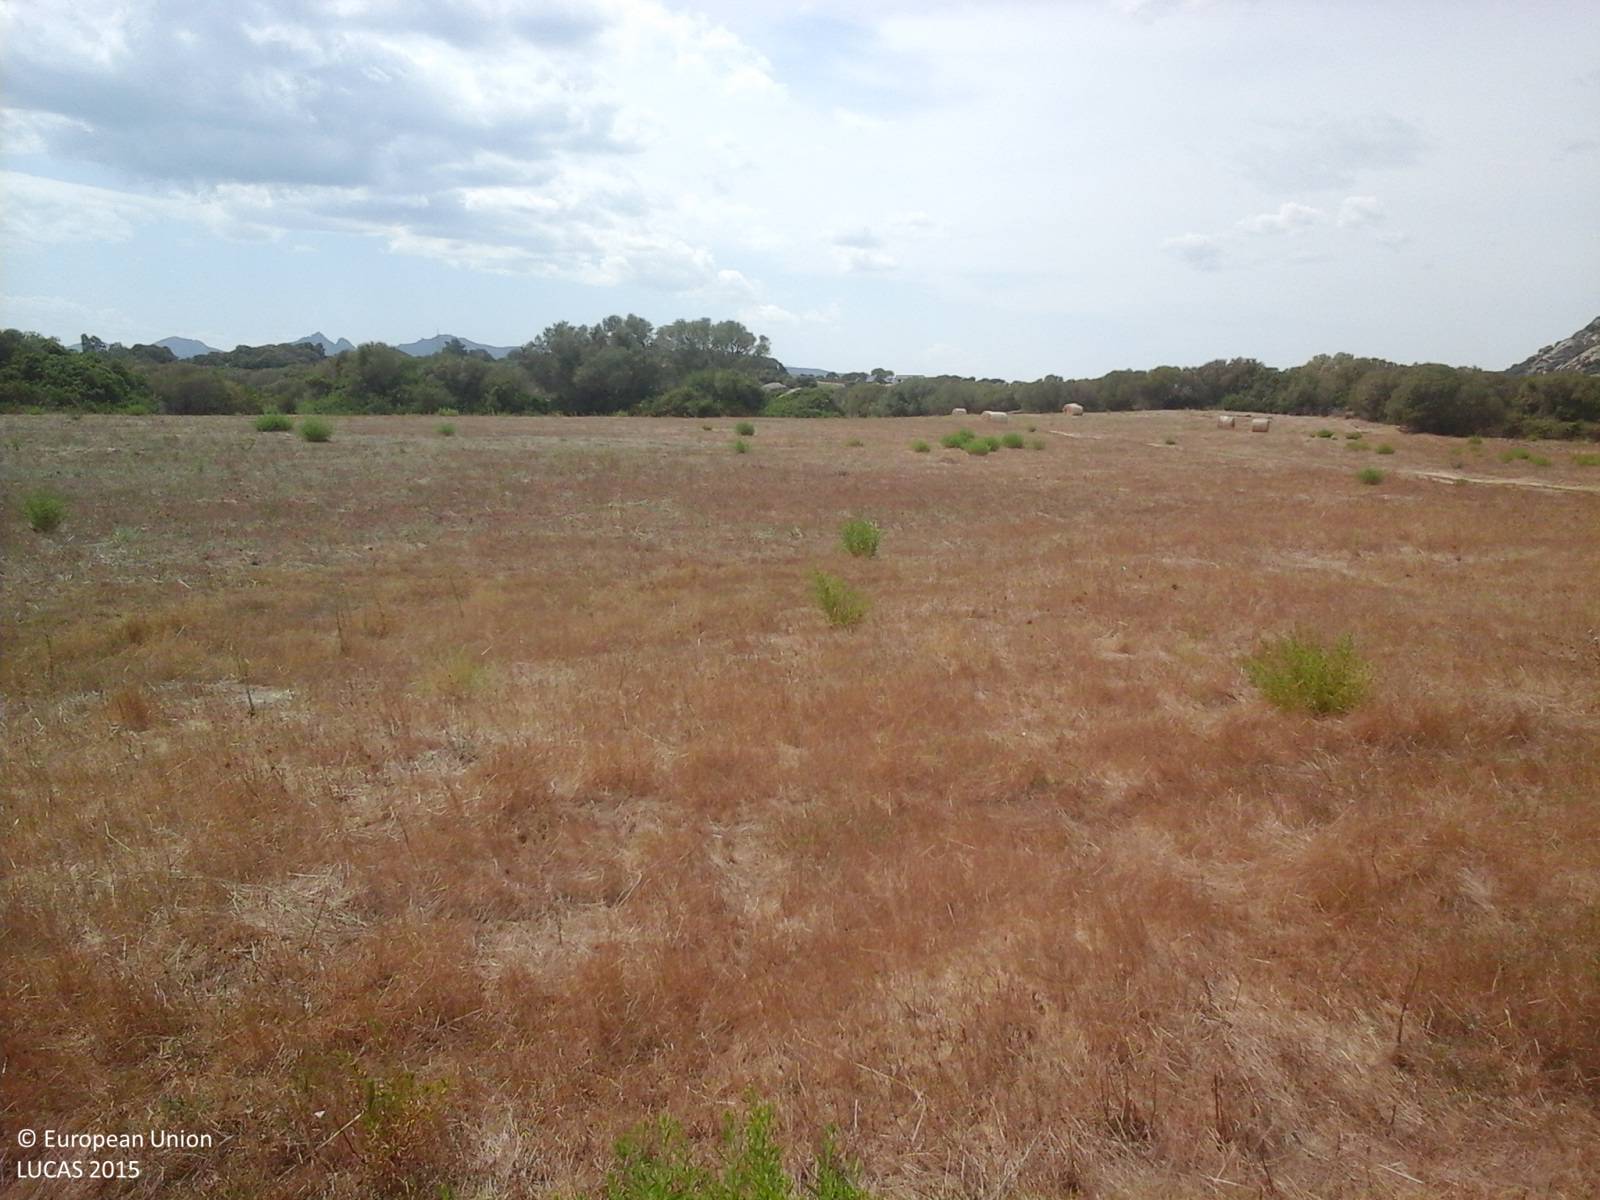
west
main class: Grassland
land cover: Grassland without tree/shrub cover
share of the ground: > 75 %
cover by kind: herbaceous plants 95 %, shrubs 5 %
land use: Agriculture (excluding fallow land and kitchen gardens)
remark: Harvested field
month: September
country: IT
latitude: 41.0800
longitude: 9.4431
